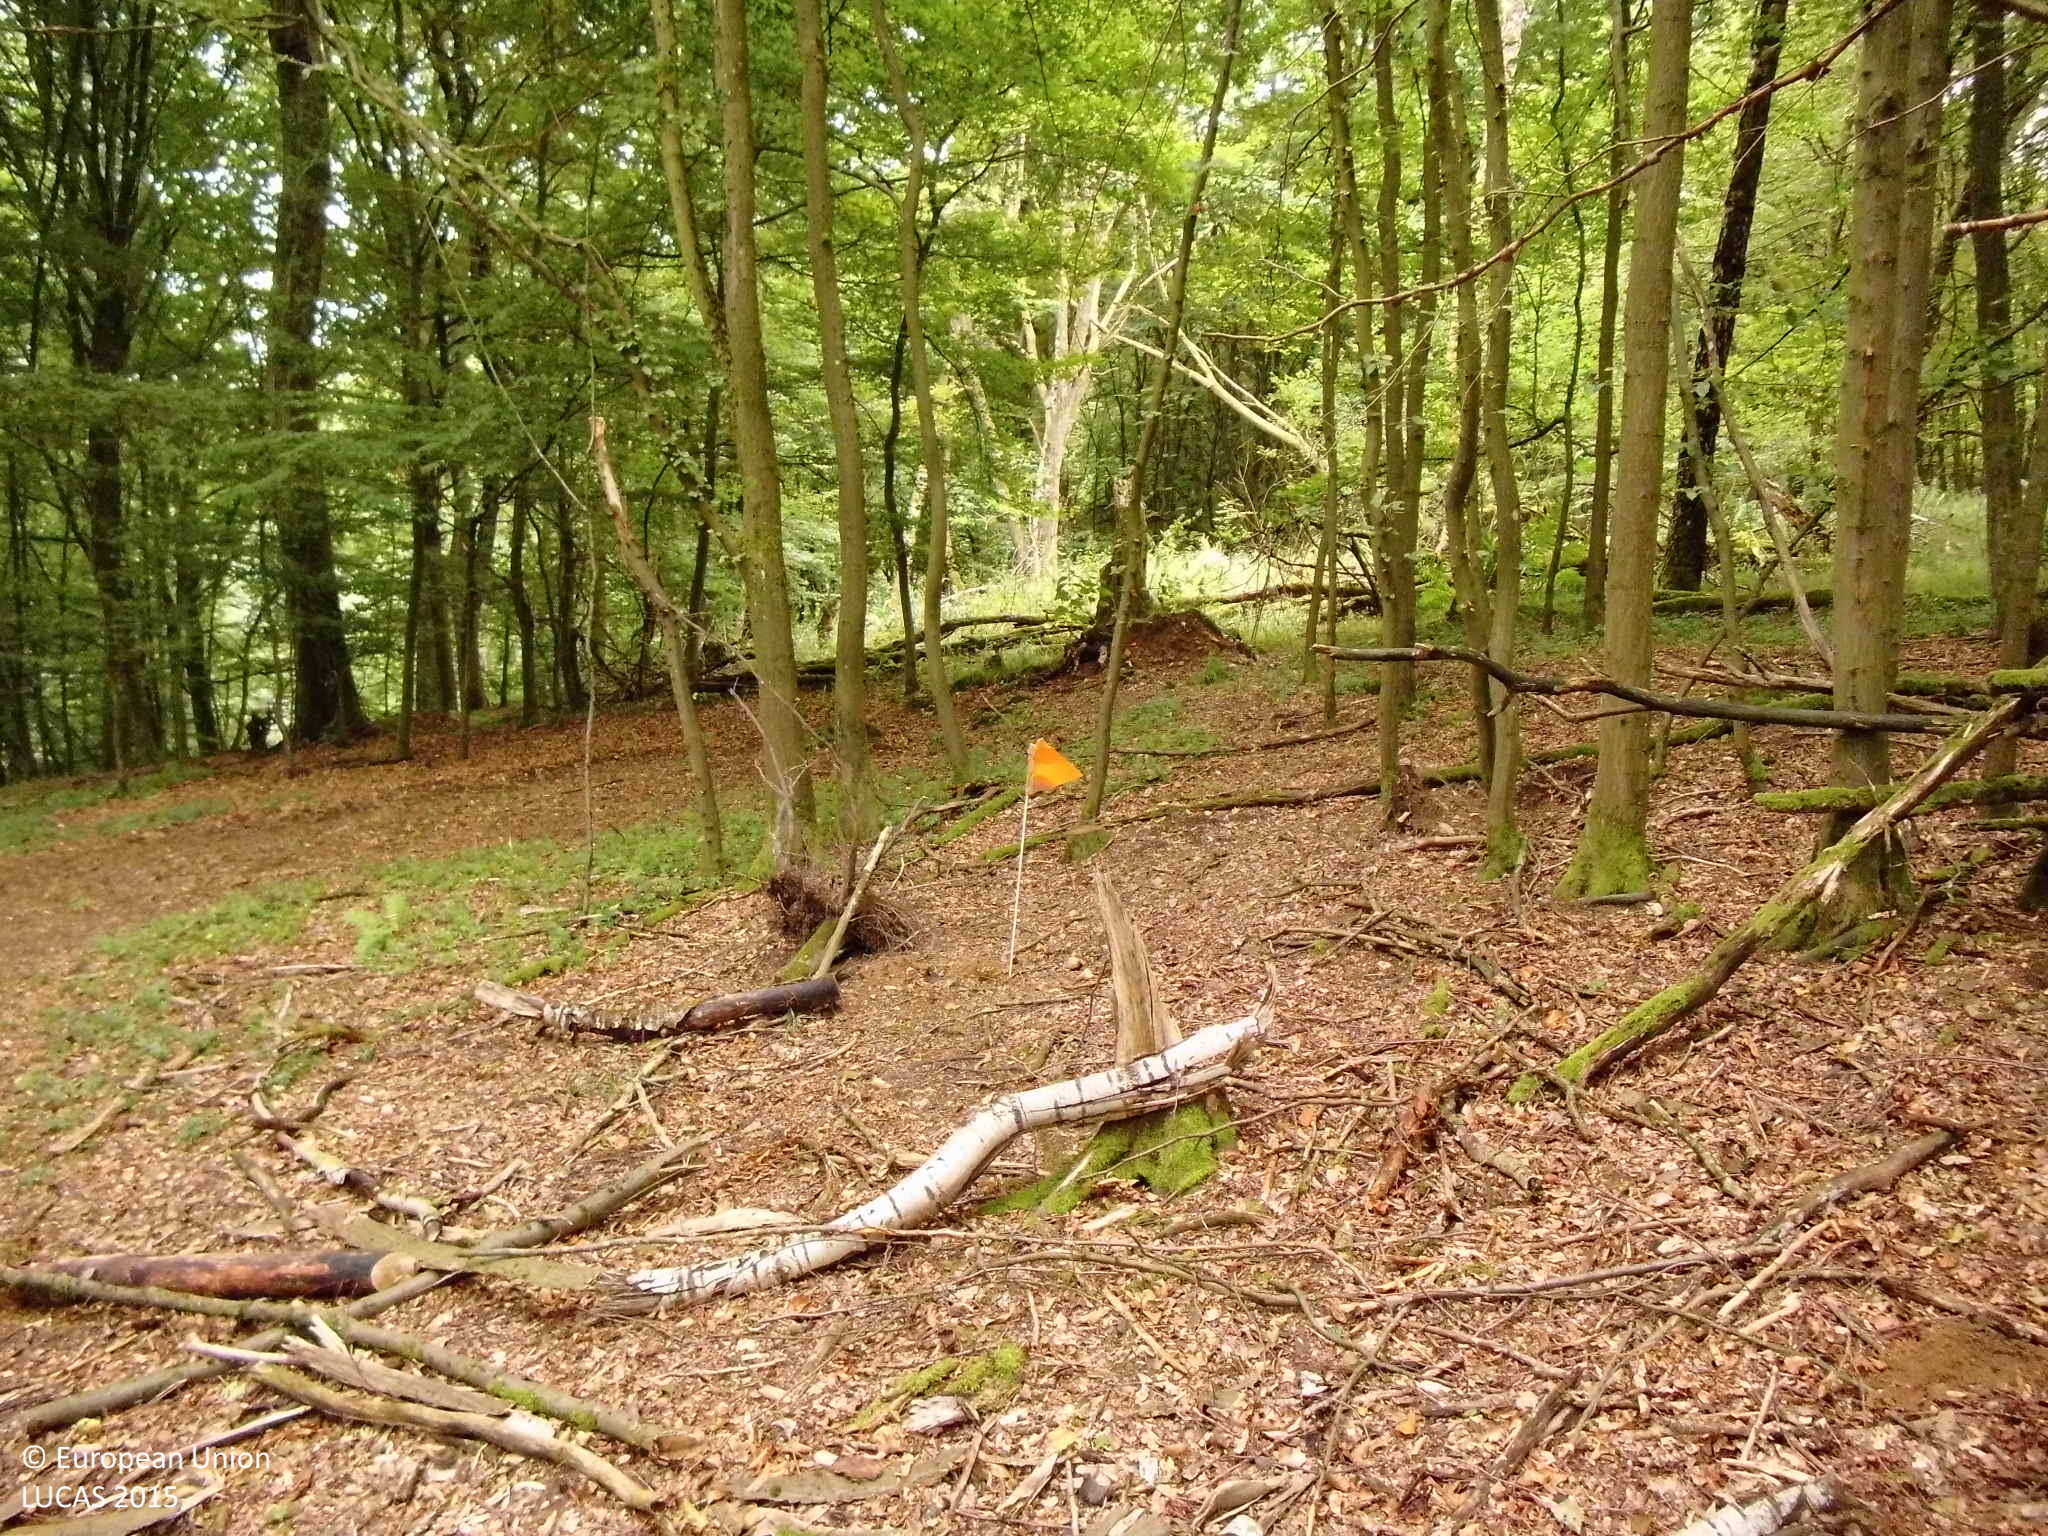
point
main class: Woodland
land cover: Broadleaved woodland
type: mesophytic deciduous forest
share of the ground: > 75 %
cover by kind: broadleaved forest trees 90 %, herbaceous plants 5 %, unconsolidated bare surface 5 %
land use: Forestry
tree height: > 5 m
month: August
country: DE
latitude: 50.6245
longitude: 8.5444
